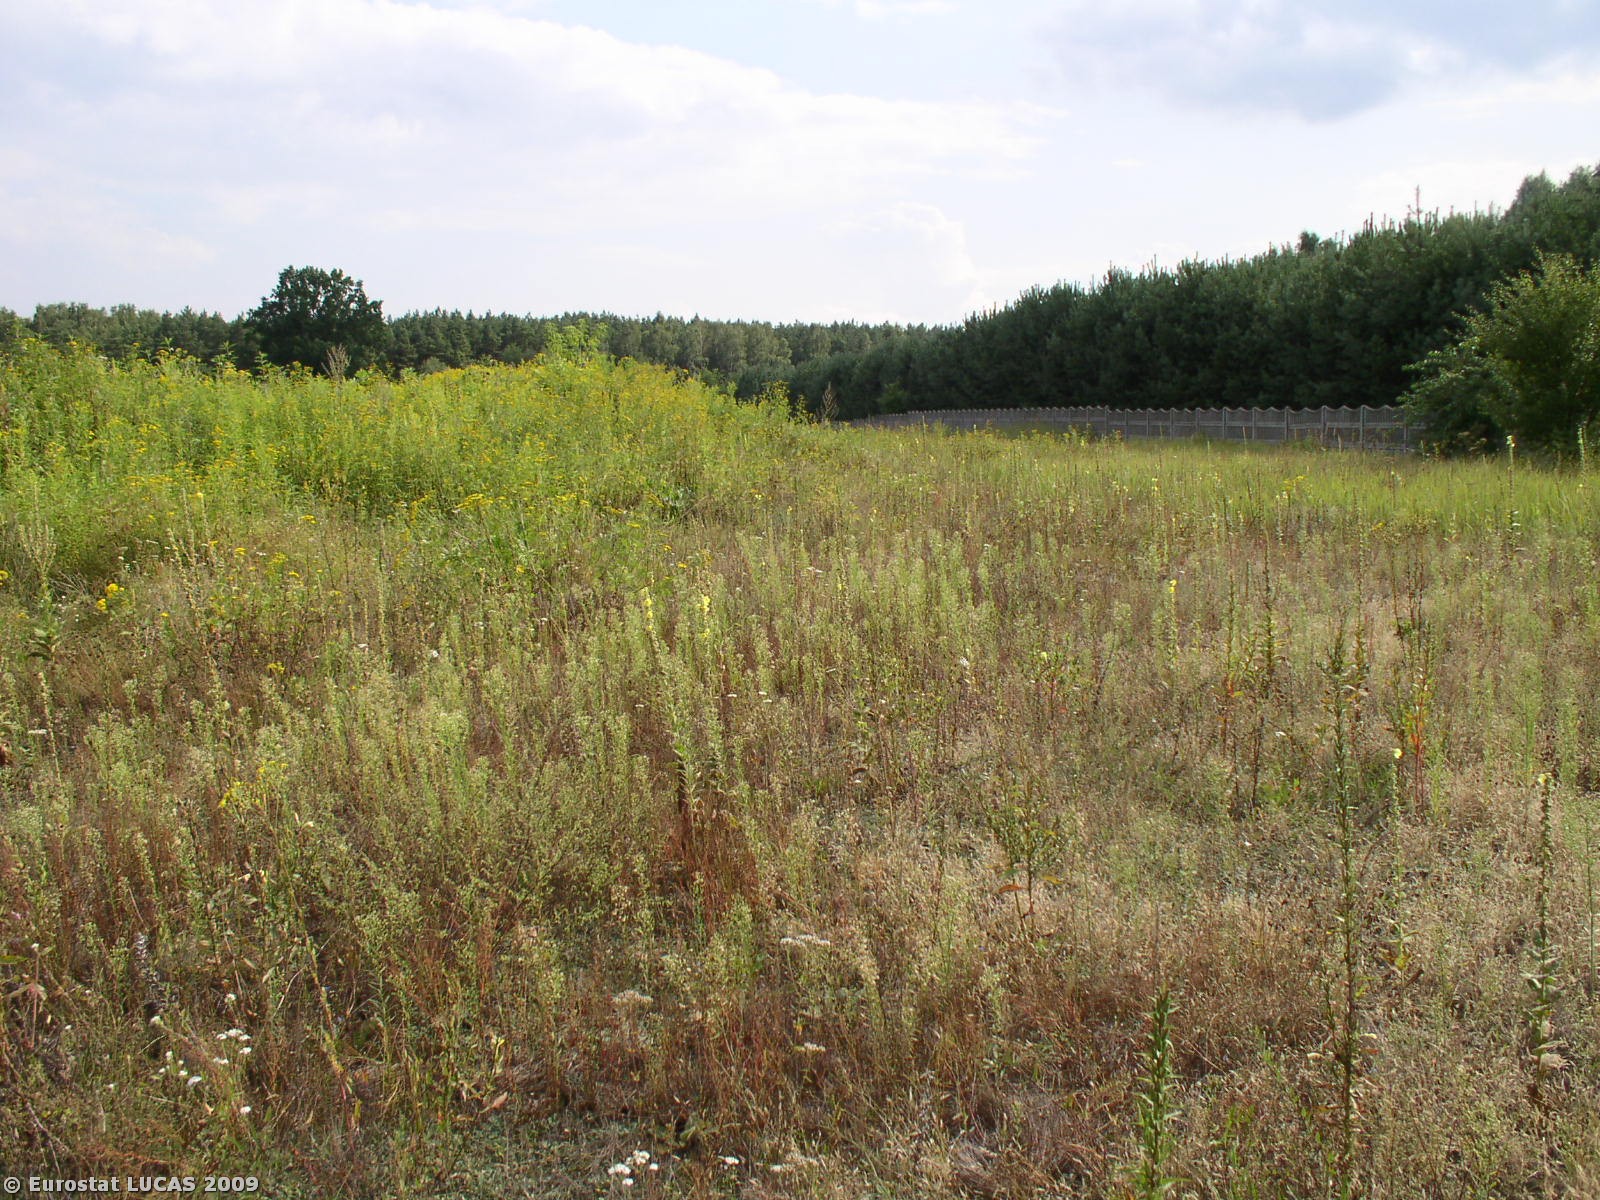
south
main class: Grassland
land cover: Spontaneously vegetated surfaces
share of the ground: > 75 %
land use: Unused
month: August
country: PL
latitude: 52.2402
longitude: 21.2506
